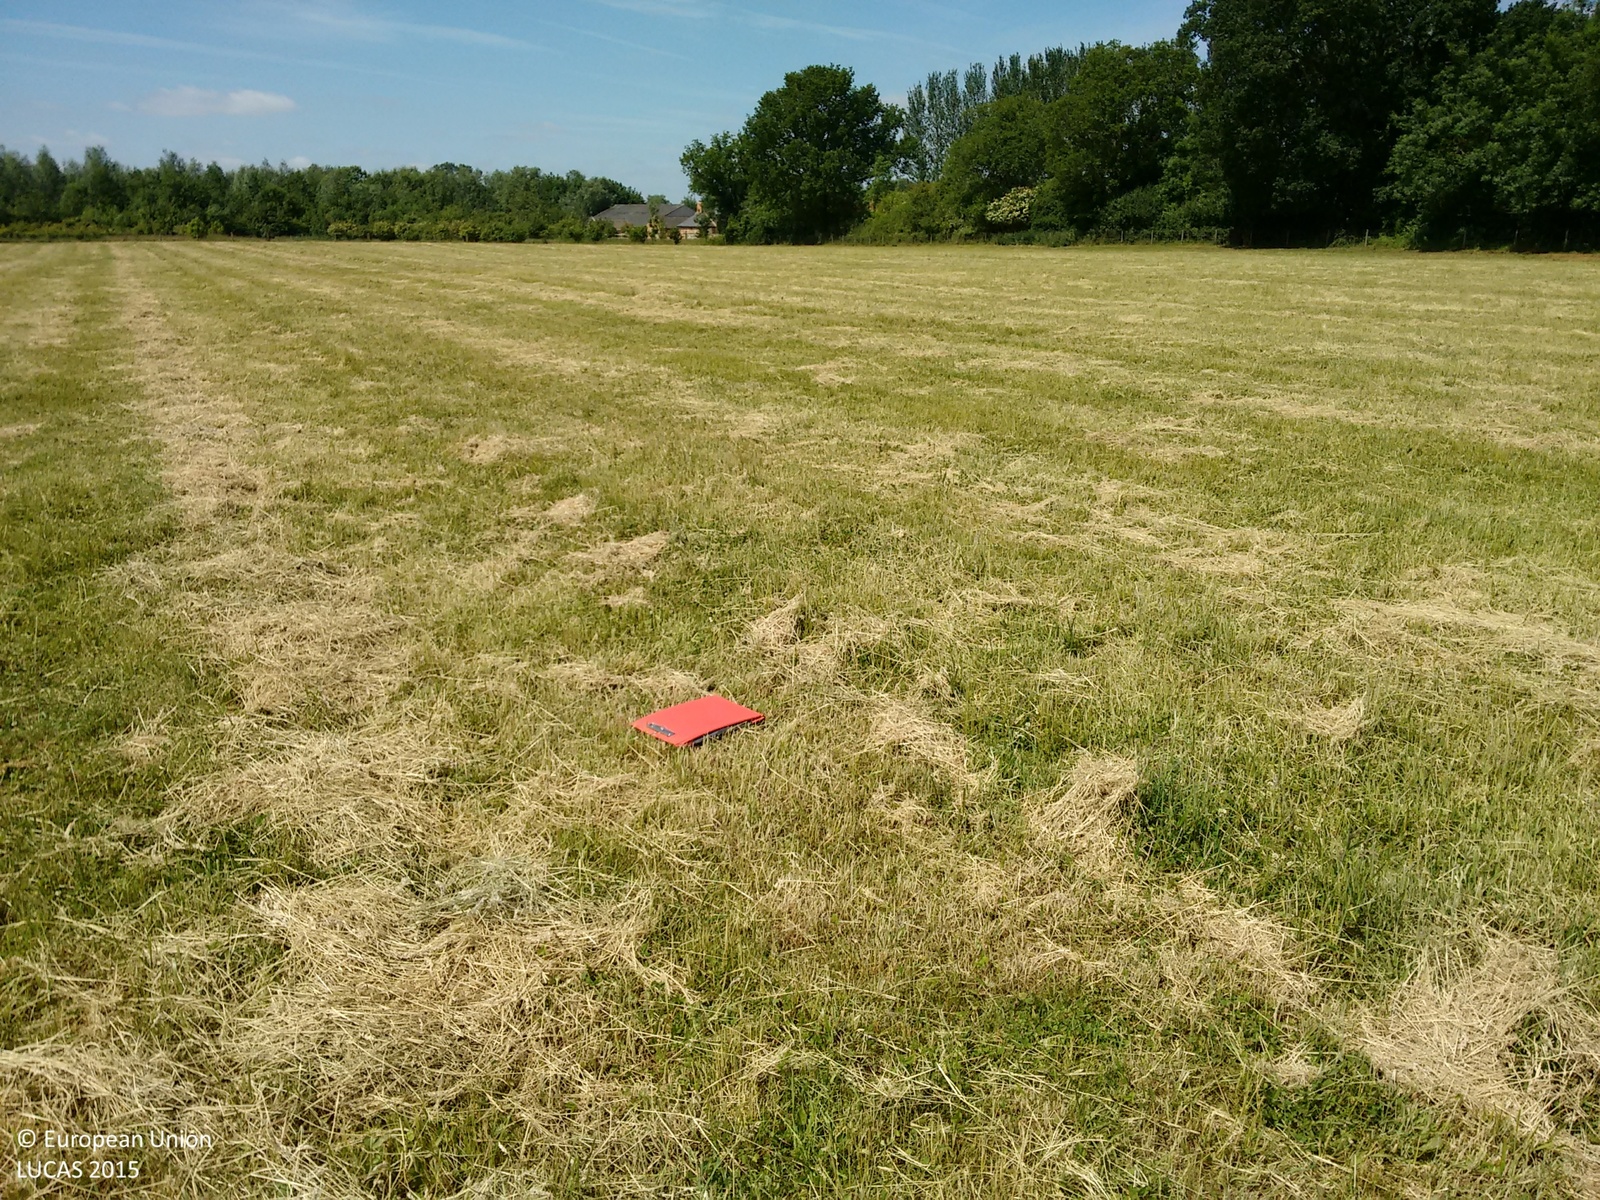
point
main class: Grassland
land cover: Grassland without tree/shrub cover
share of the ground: > 75 %
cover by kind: herbaceous plants 100 %
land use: Agriculture (excluding fallow land and kitchen gardens)
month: June
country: GB
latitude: 51.8679
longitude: -1.1566
